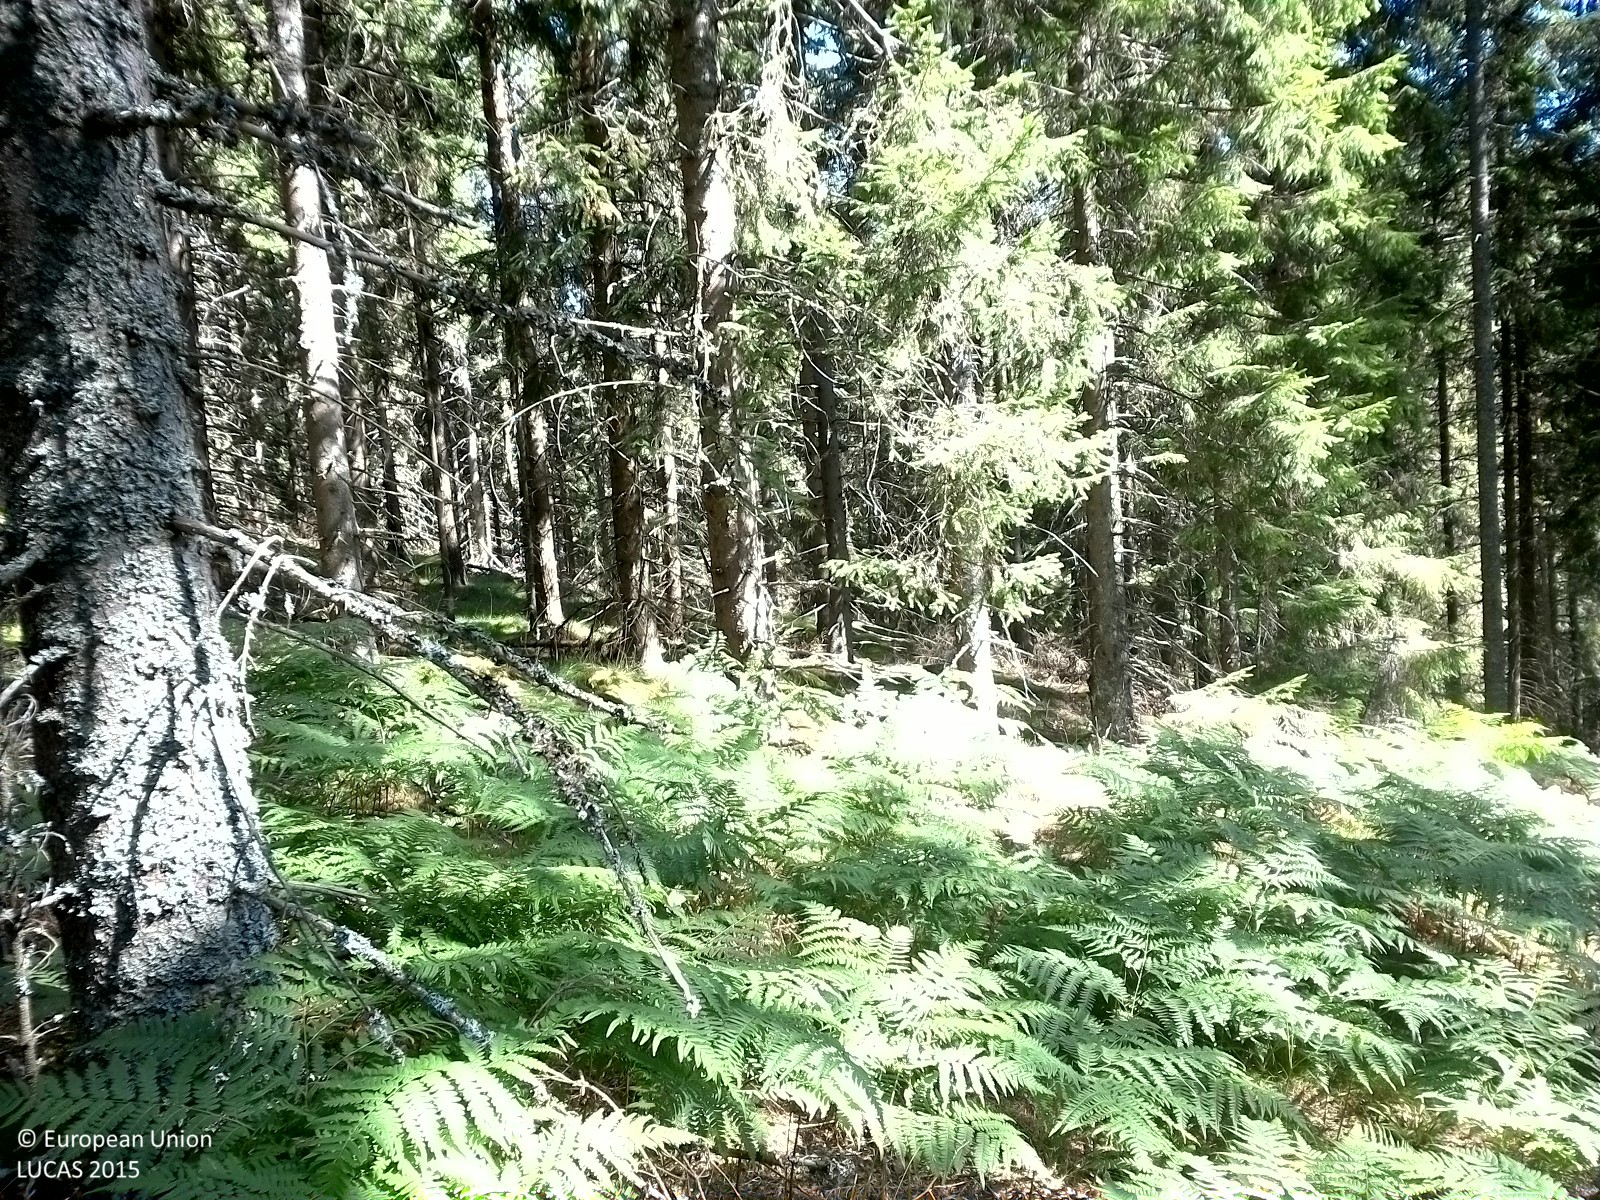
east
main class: Woodland
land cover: Spruce dominated coniferous woodland
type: boreal forest
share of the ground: 25 - 50 %
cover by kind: coniferous forest trees 40 %, herbaceous plants 30 %, lichens and mosses 30 %
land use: Forestry
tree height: > 5 m
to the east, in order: Spruce dominated coniferous woodland; Ditches and canals; Grass margins; Paved roads, cycling and walking lanes; Grass margins; Spruce dominated coniferous woodland; Rivers and streams; Spruce dominated coniferous woodland; Other coniferous woodland; Other mixed woodland; Other coniferous woodland
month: August
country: SE
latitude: 59.2534
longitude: 14.7440
